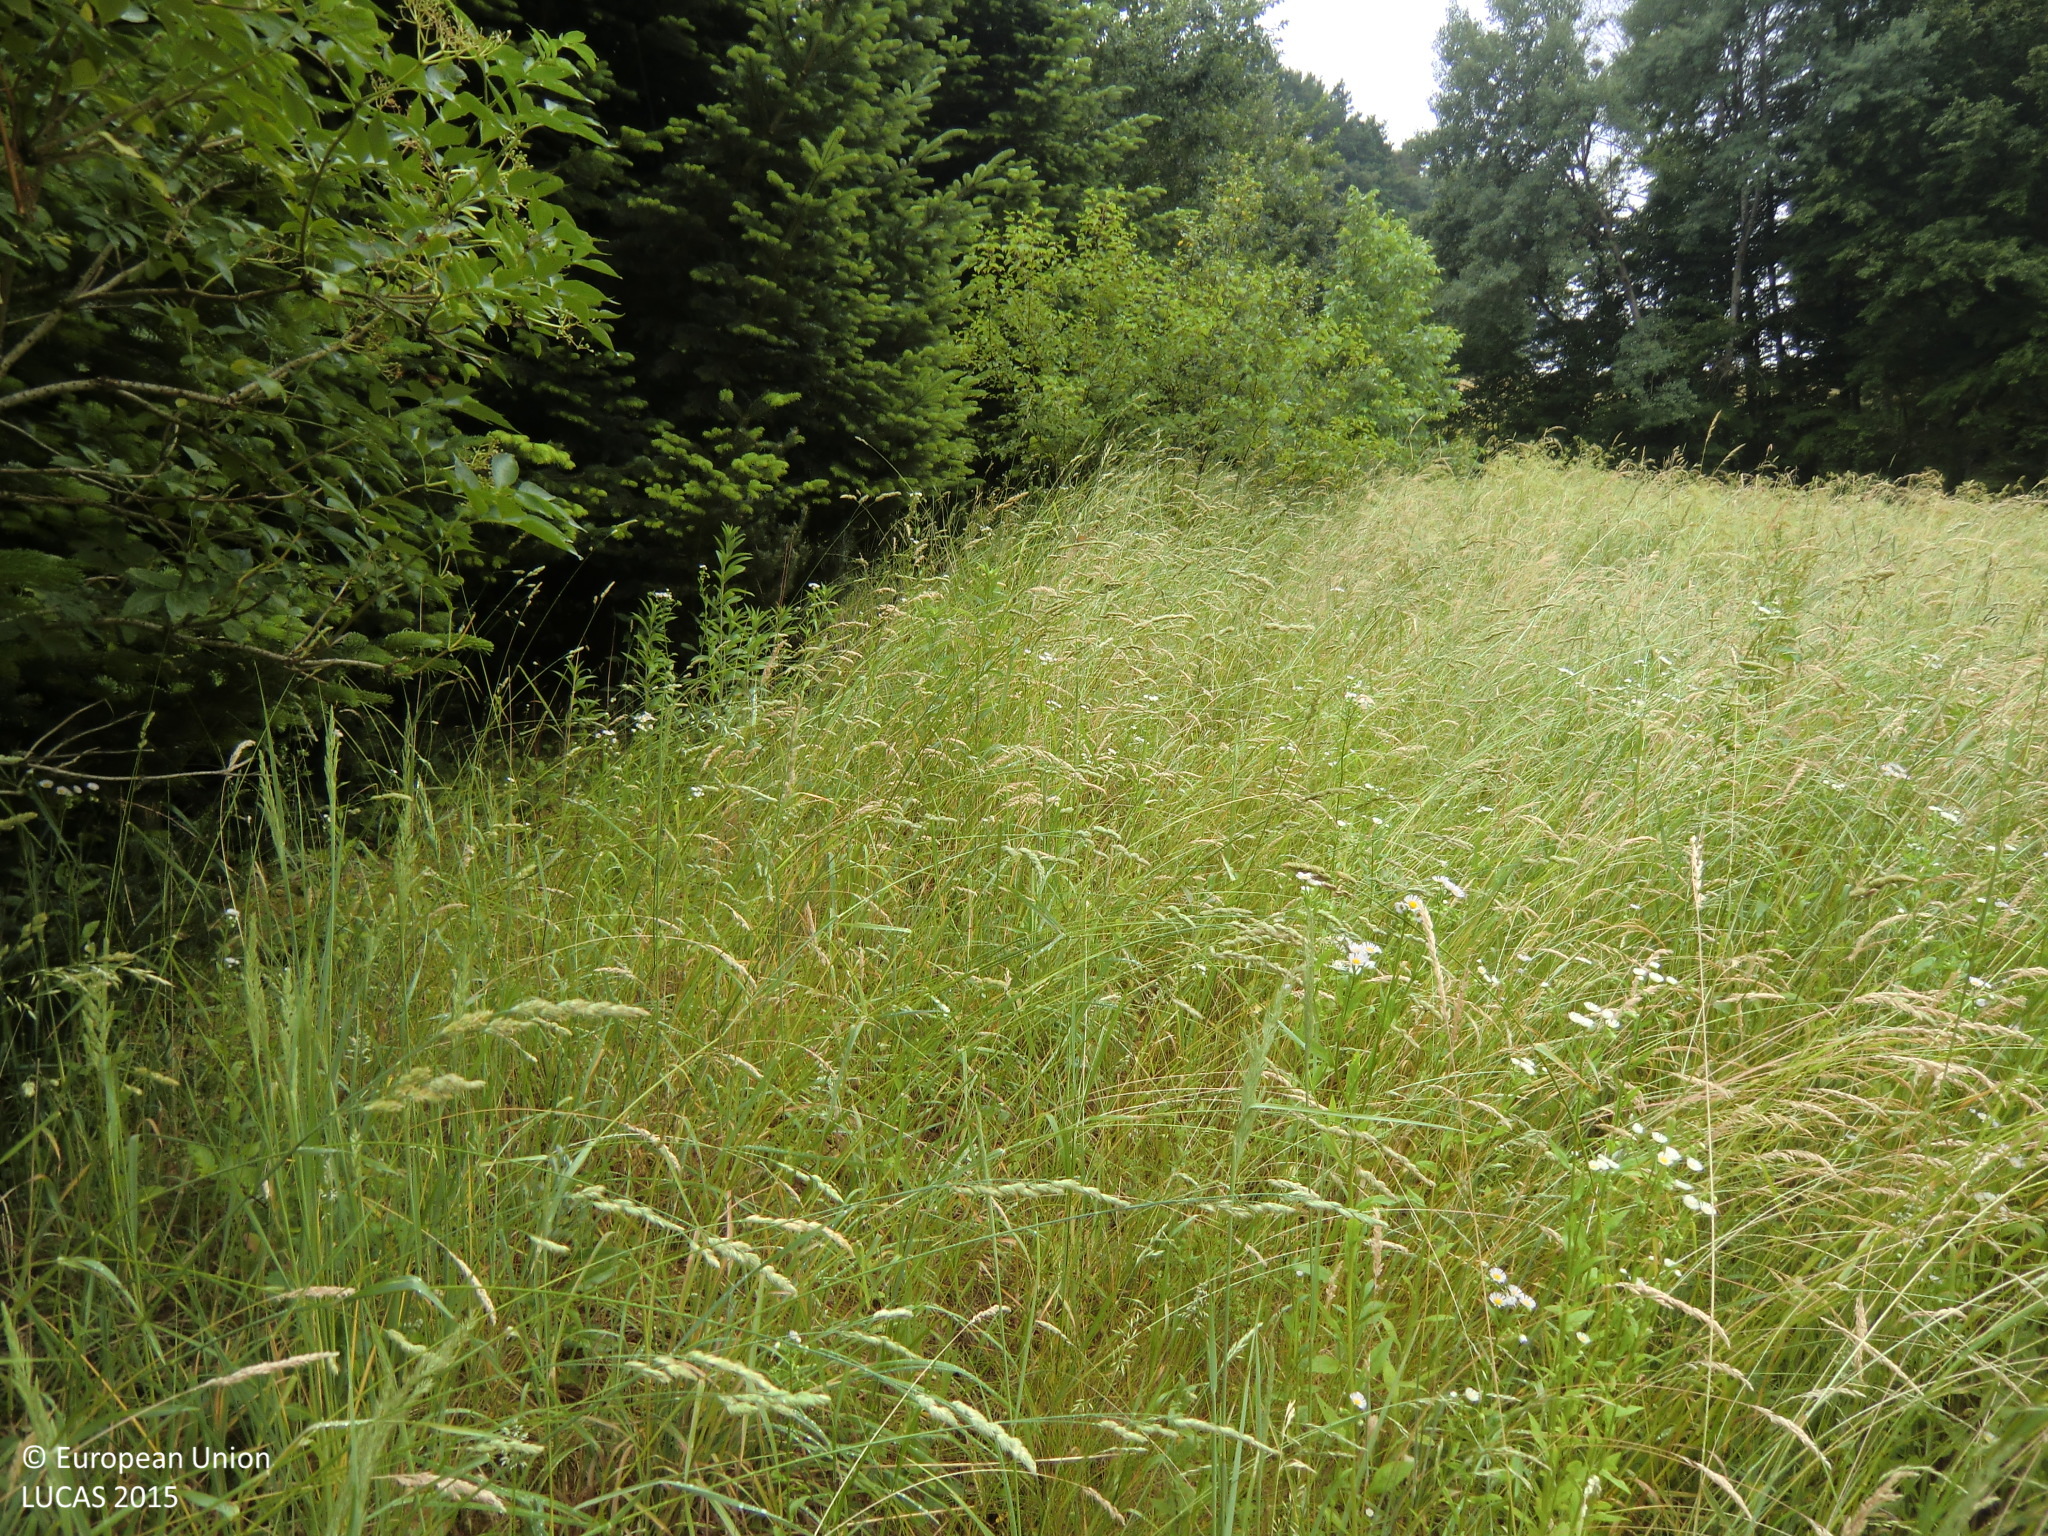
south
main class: Grassland
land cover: Grassland without tree/shrub cover
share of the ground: > 75 %
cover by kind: herbaceous plants 100 %
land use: Agriculture (excluding fallow land and kitchen gardens)
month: June
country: AT
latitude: 47.1935
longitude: 16.0069
